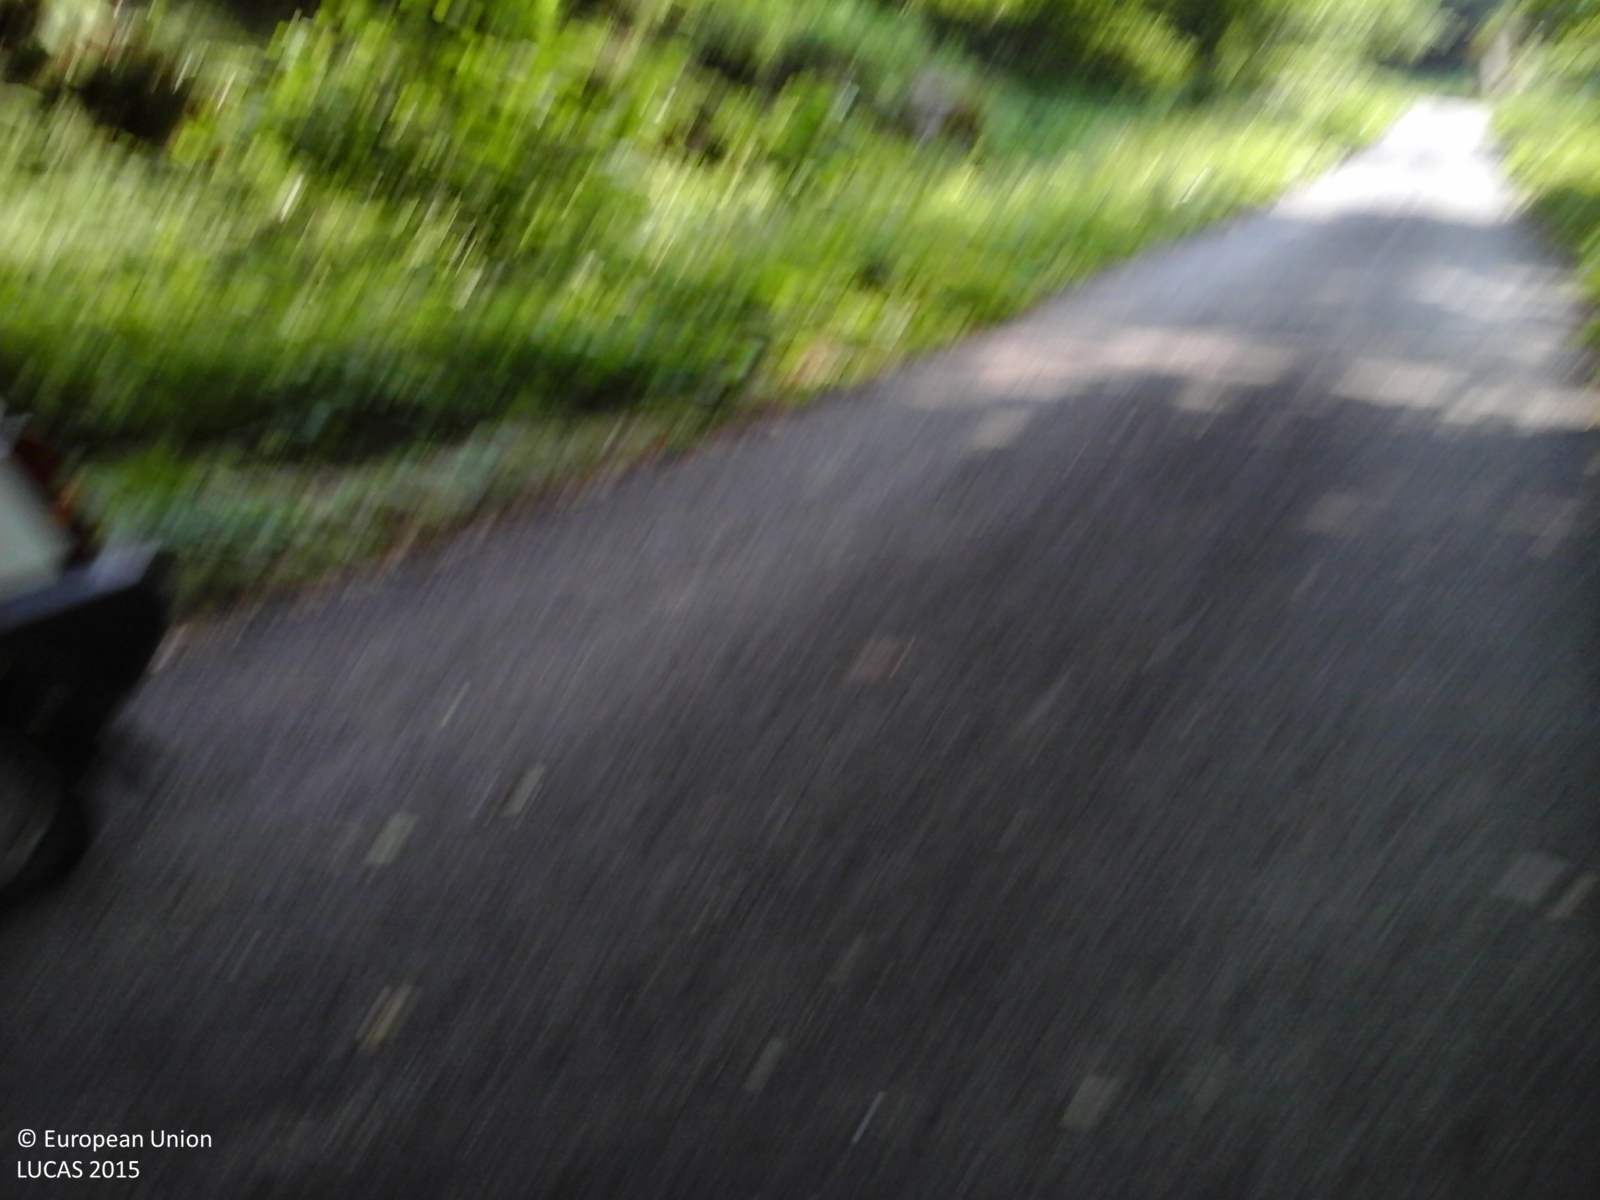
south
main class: Woodland
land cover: Broadleaved woodland
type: mountainous beech forest
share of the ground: > 75 %
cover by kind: broadleaved forest trees 100 %
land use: Forestry
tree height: > 5 m
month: July
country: IT
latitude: 44.4045
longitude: 7.2557
